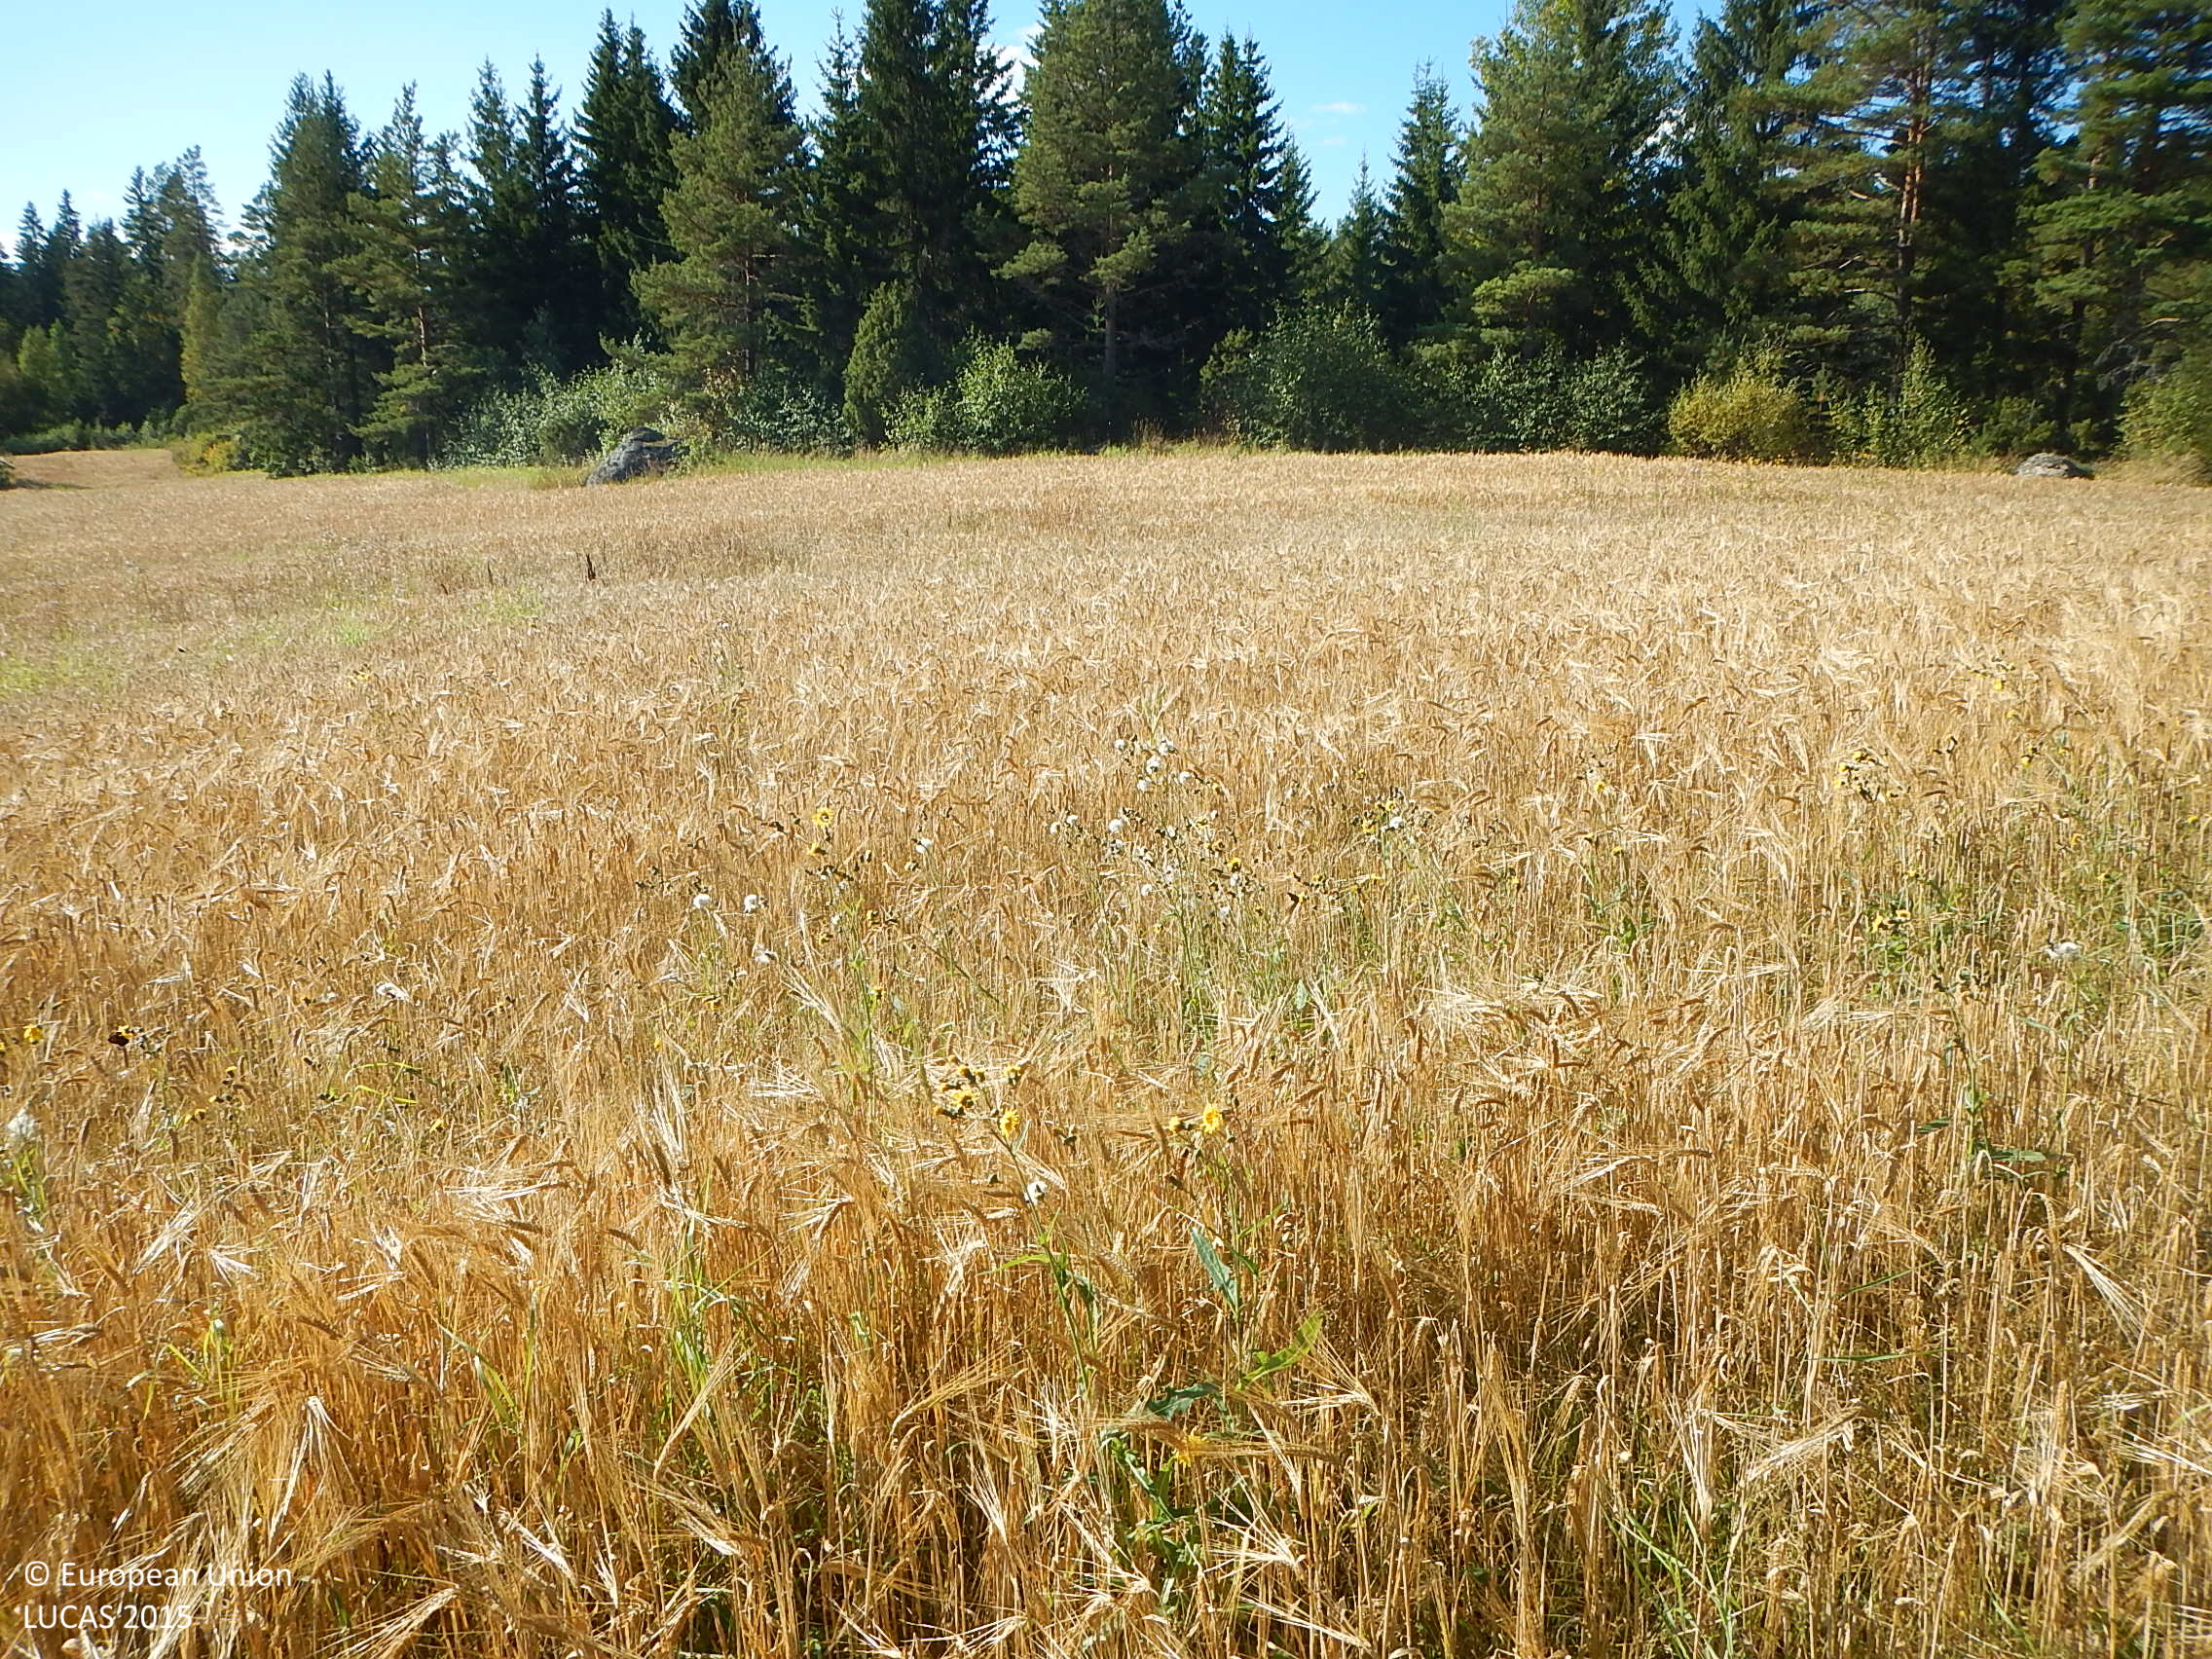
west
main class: Cropland
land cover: Barley
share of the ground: > 75 %
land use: Agriculture (excluding fallow land and kitchen gardens)
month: September
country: FI
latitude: 61.5921
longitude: 22.7473
